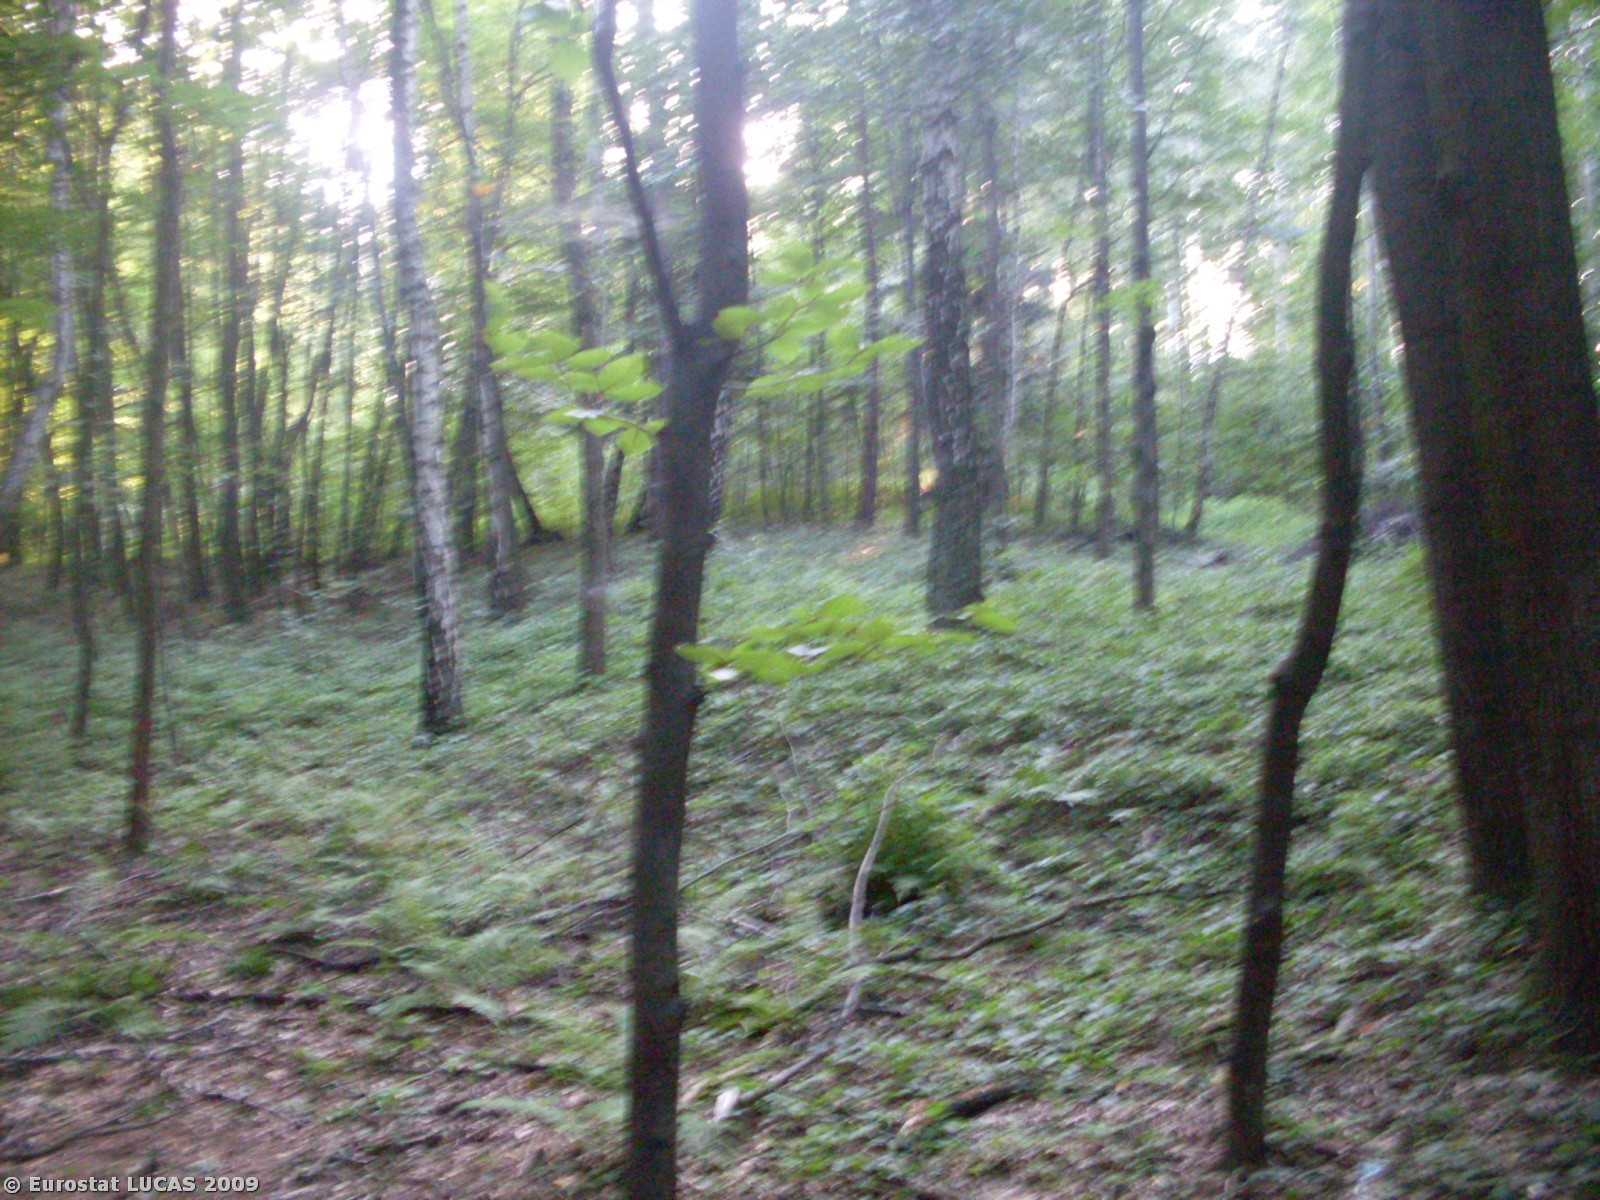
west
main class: Woodland
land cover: Broadleaved woodland
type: mesophytic deciduous forest
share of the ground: > 75 %
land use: Forestry
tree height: > 5 m
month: August
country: PL
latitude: 49.9182
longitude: 20.6660
